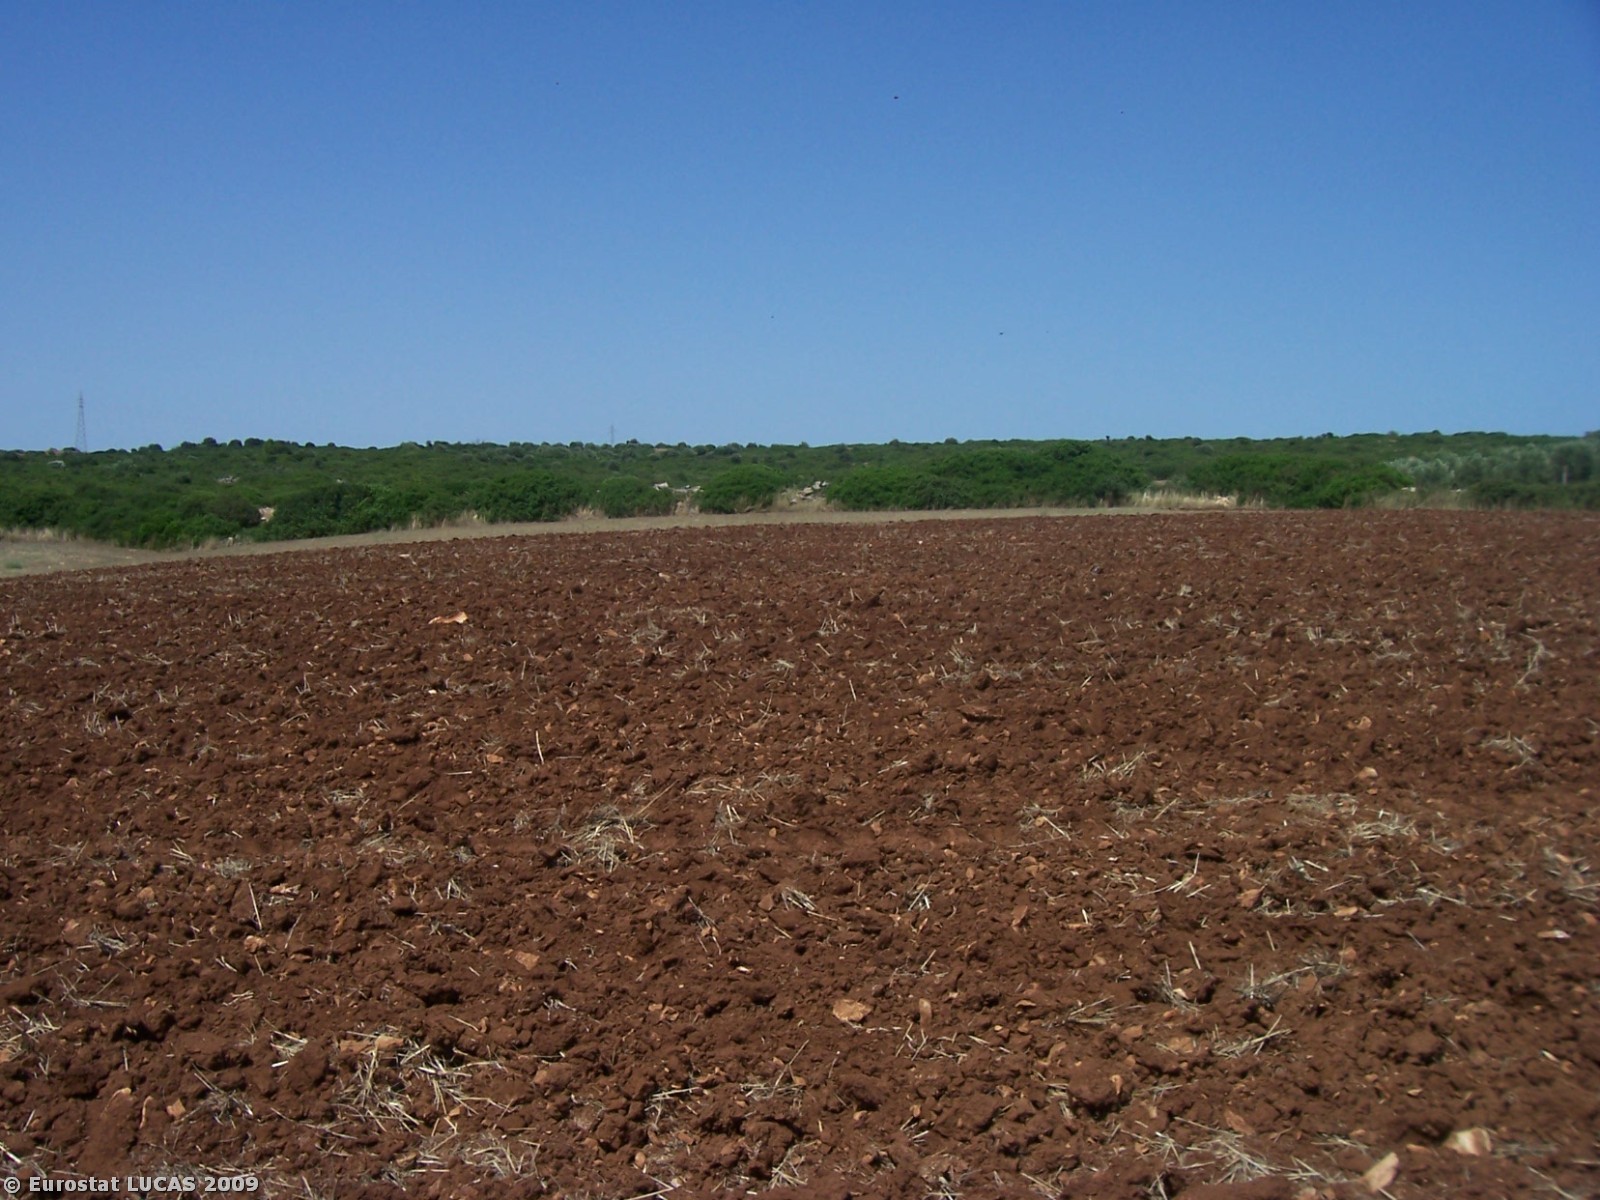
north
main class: Cropland
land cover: Durum wheat
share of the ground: < 10 %
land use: Agriculture (excluding fallow land and kitchen gardens)
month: July
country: IT
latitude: 40.6696
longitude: 17.0154
